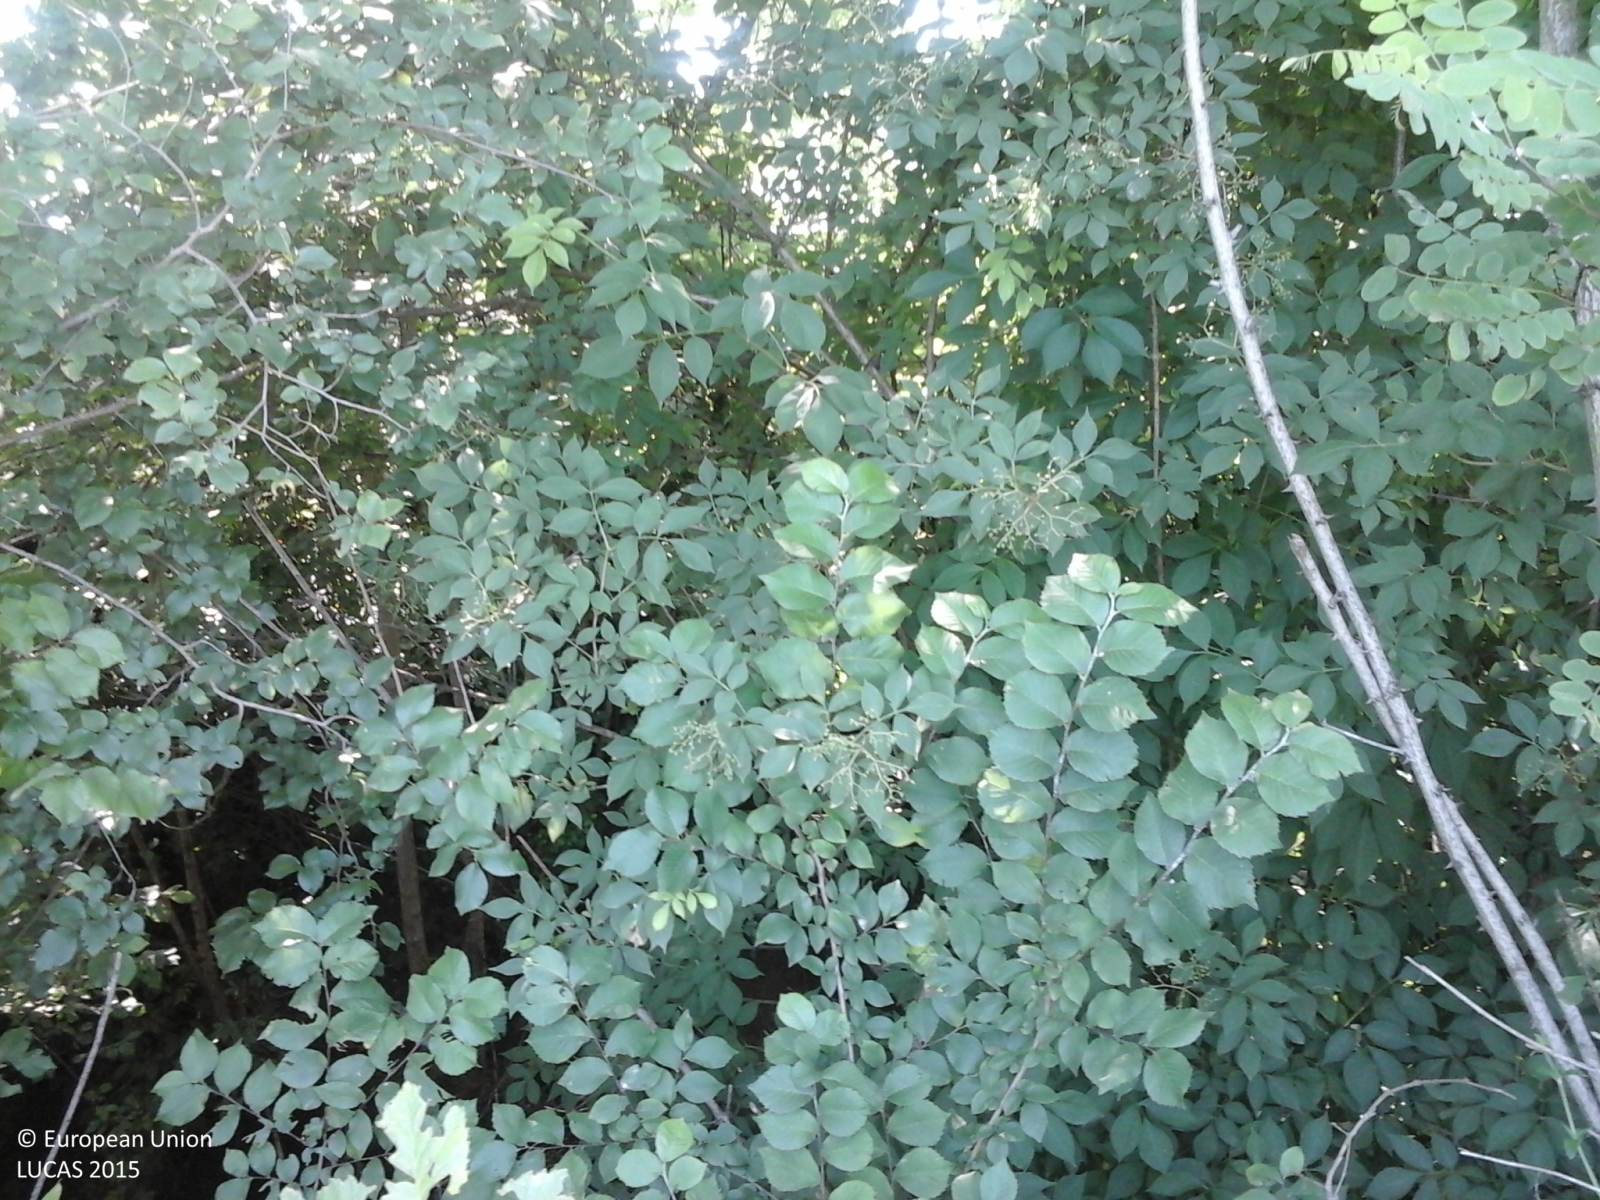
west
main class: Grassland
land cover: Grassland without tree/shrub cover
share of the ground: > 75 %
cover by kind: herbaceous plants 100 %
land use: Agriculture (excluding fallow land and kitchen gardens)
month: June
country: IT
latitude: 45.0025
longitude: 8.2145
